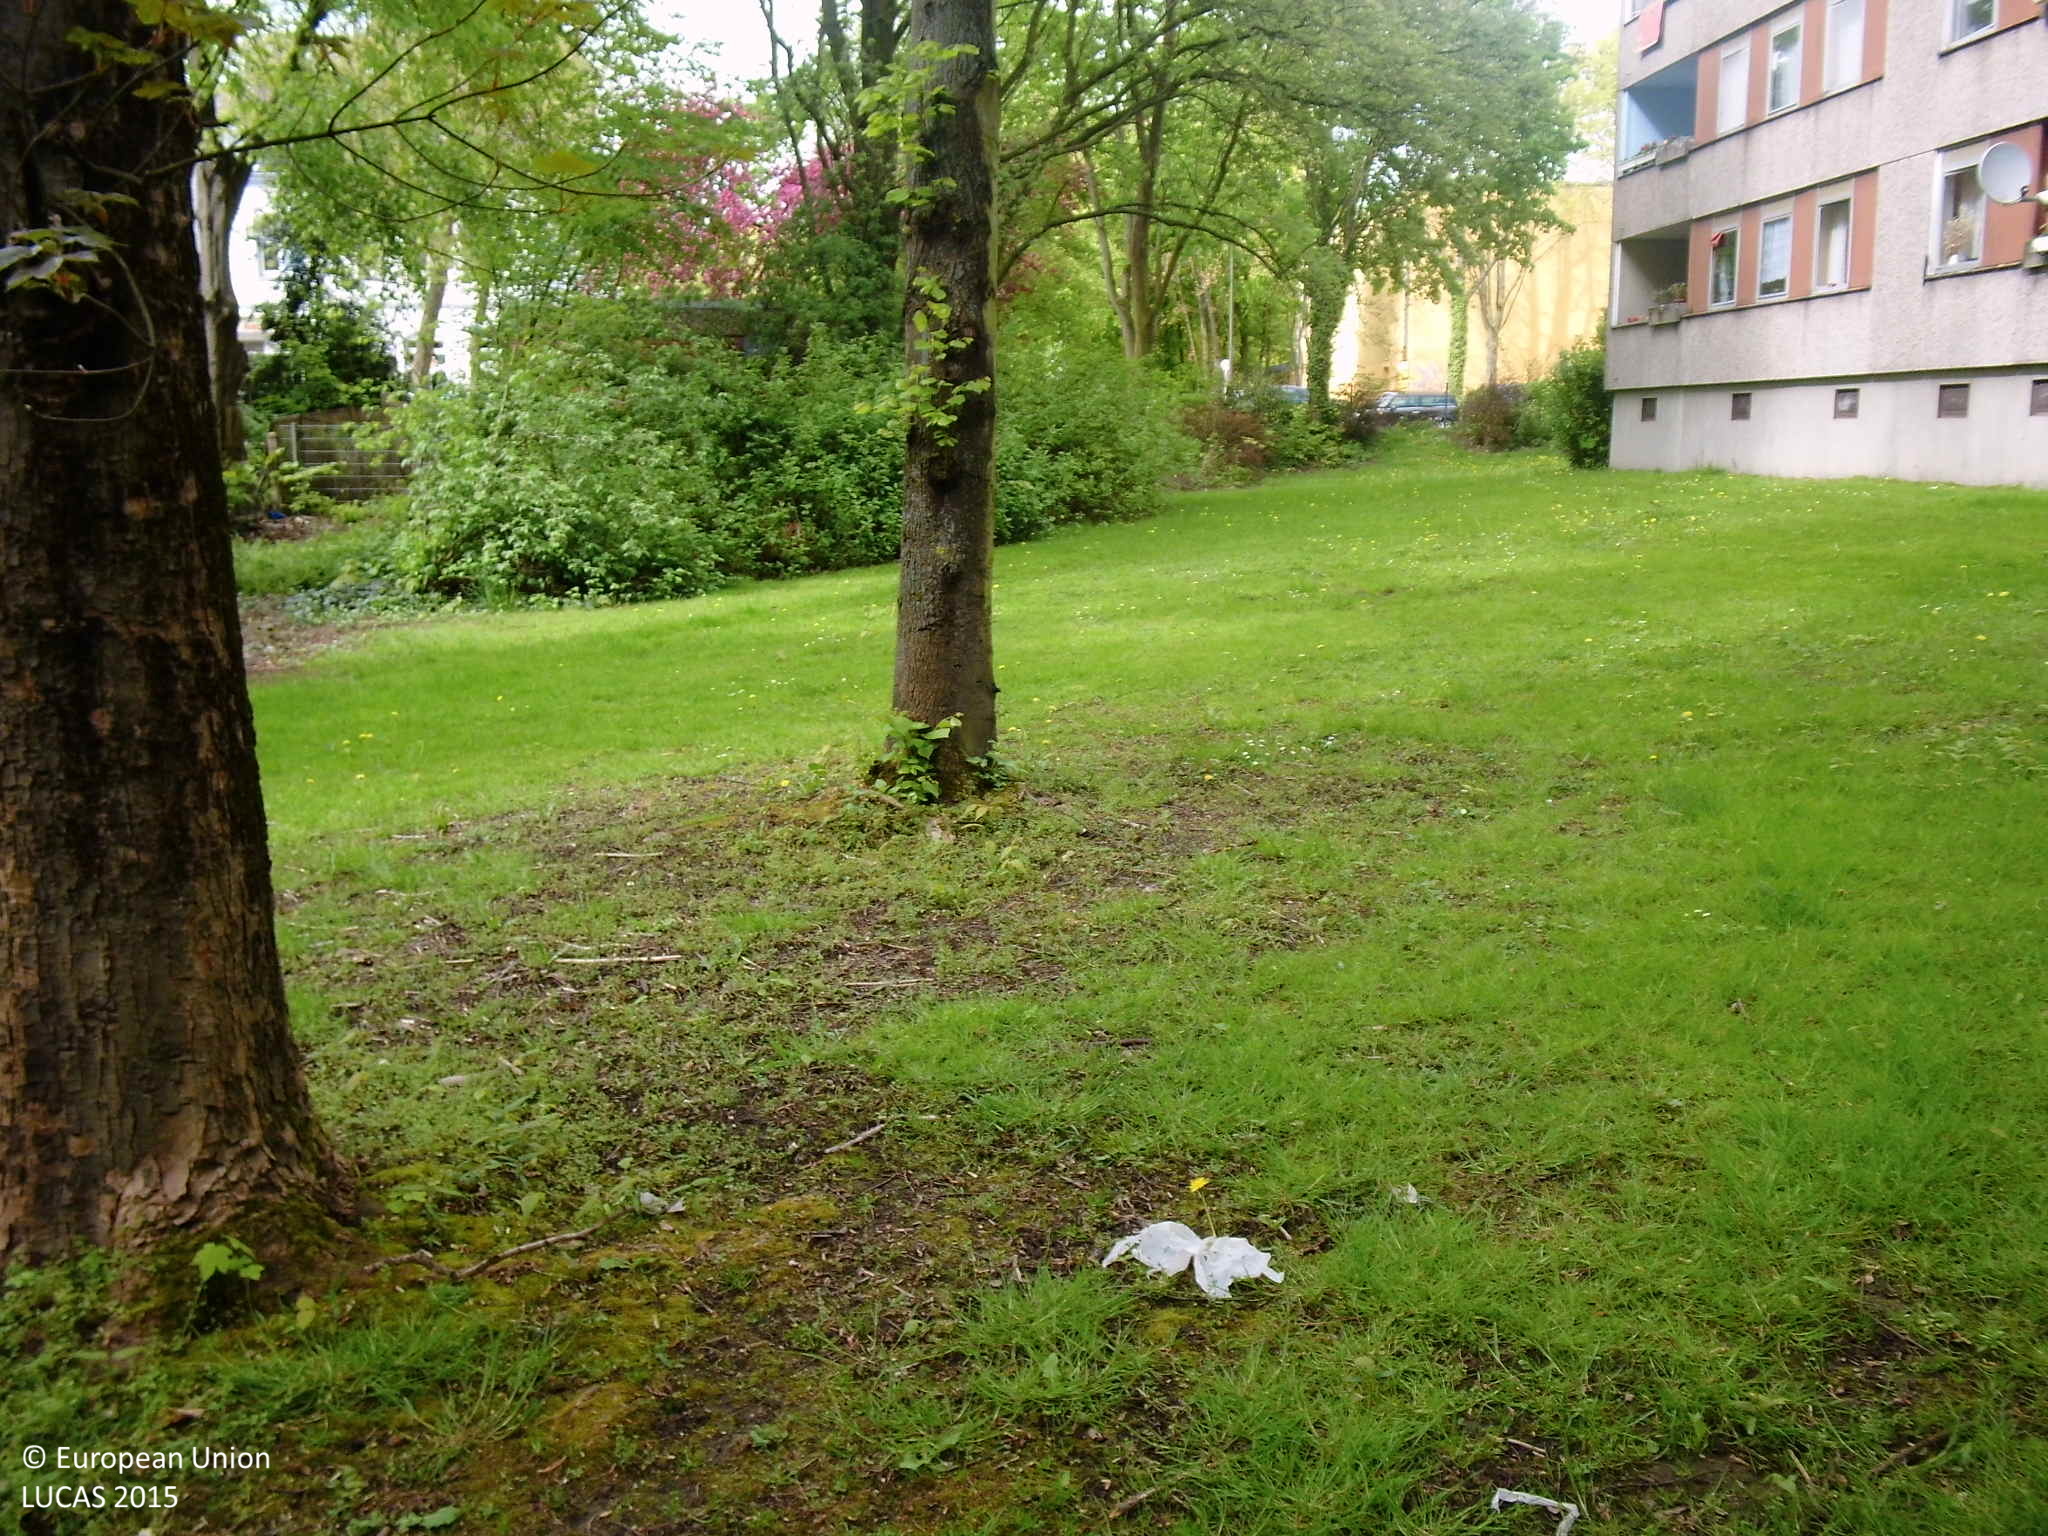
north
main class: Woodland
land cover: Broadleaved woodland
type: mesophytic deciduous forest
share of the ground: > 75 %
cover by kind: broadleaved forest trees 75 %, shrubs 10 %, herbaceous plants 10 %, unconsolidated bare surface 5 %
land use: Residential
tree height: > 5 m
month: May
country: DE
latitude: 51.5575
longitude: 7.3895
